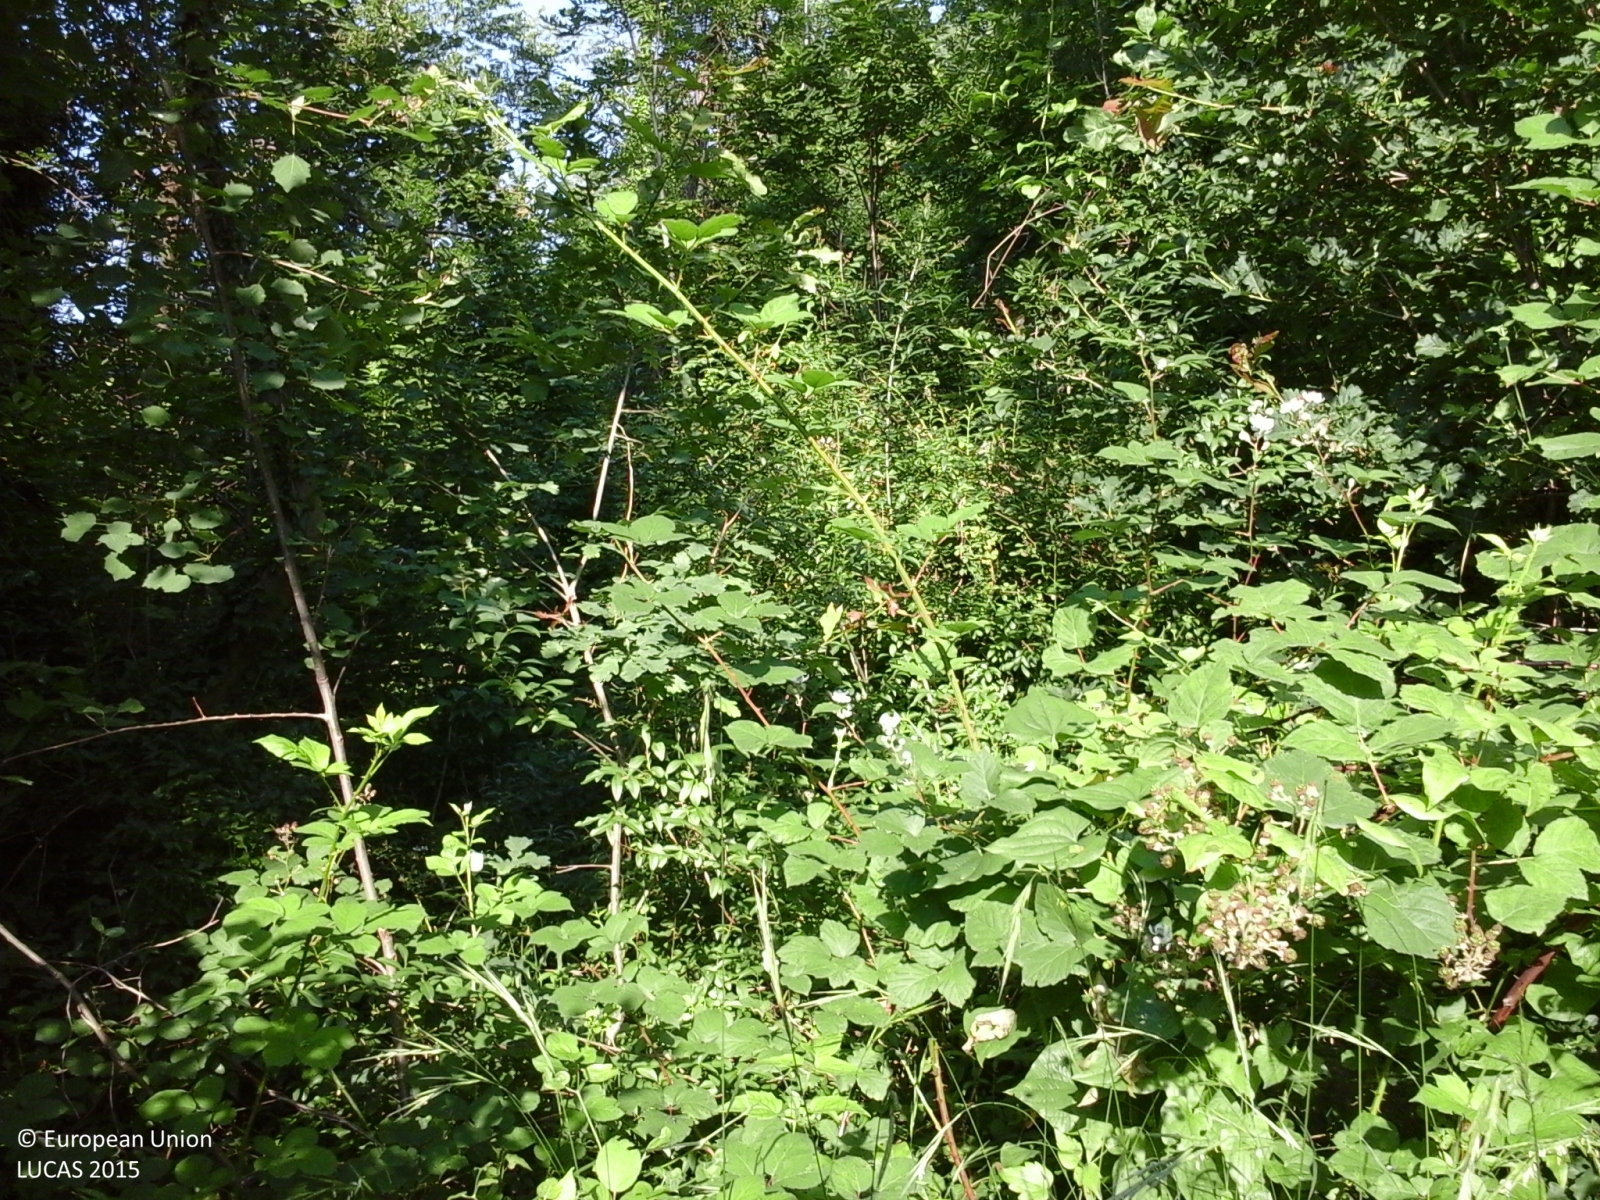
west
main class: Woodland
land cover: Broadleaved woodland
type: thermophilous deciduous forest
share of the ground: > 75 %
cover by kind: broadleaved forest trees 90 %, shrubs 10 %
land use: Semi-natural and natural areas not in use
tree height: > 5 m
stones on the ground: < 10 %
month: June
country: IT
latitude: 44.5532
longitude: 7.4245
